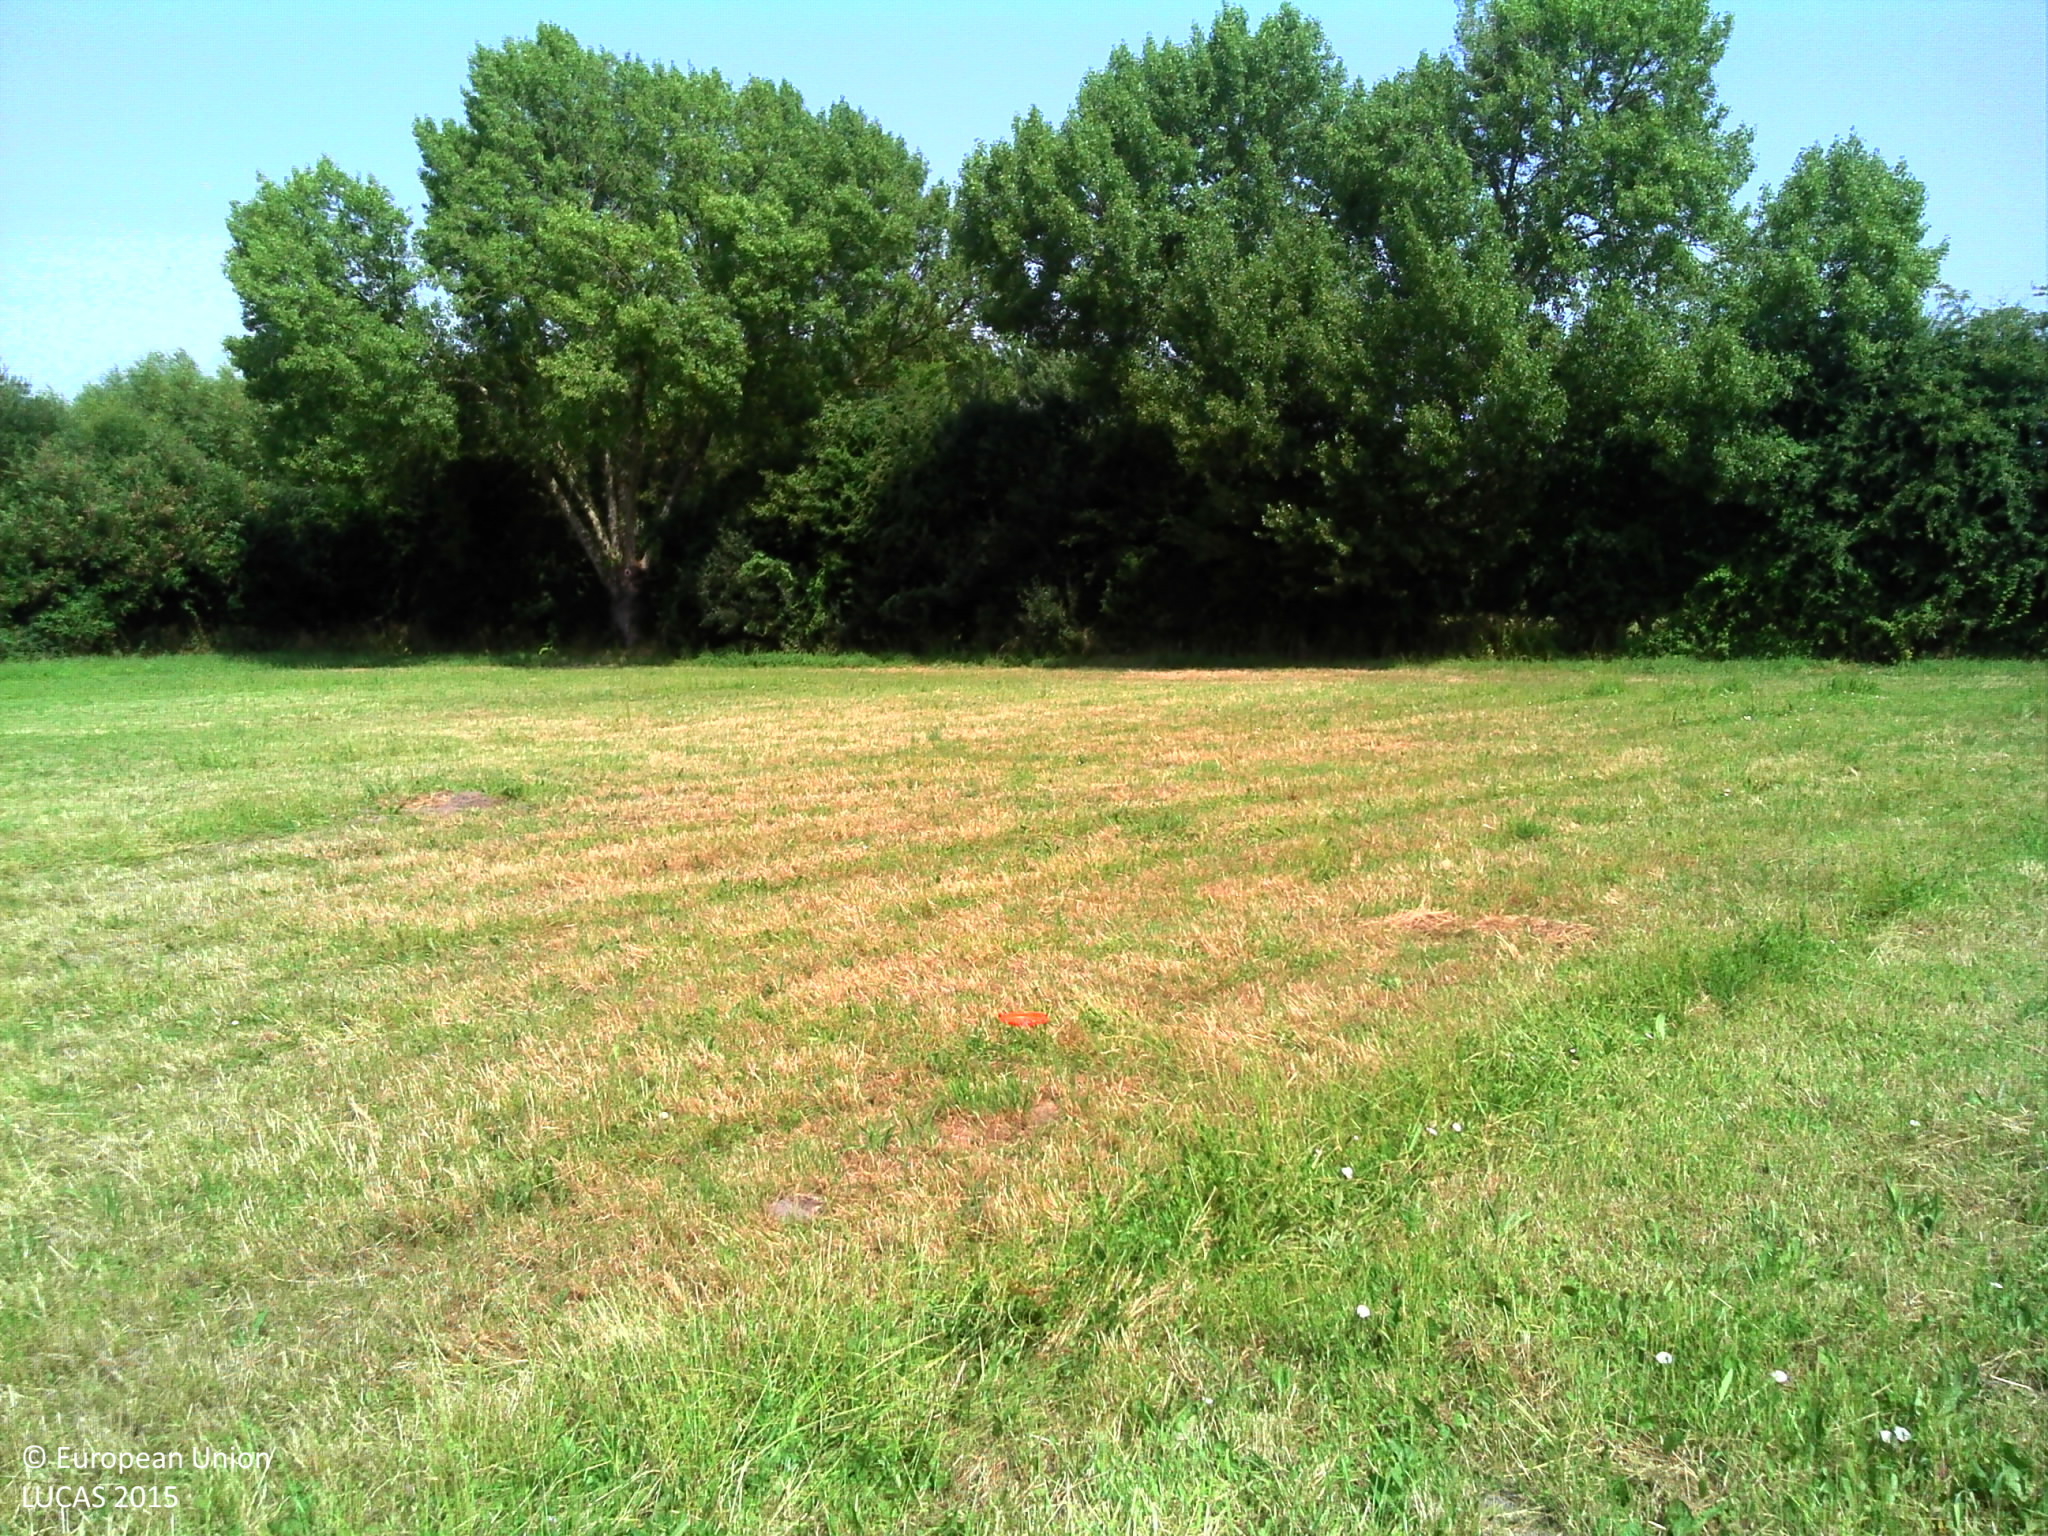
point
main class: Grassland
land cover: Grassland without tree/shrub cover
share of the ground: > 75 %
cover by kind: herbaceous plants 100 %
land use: Agriculture (excluding fallow land and kitchen gardens)
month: July
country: FR
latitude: 48.8868
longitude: -1.5455
